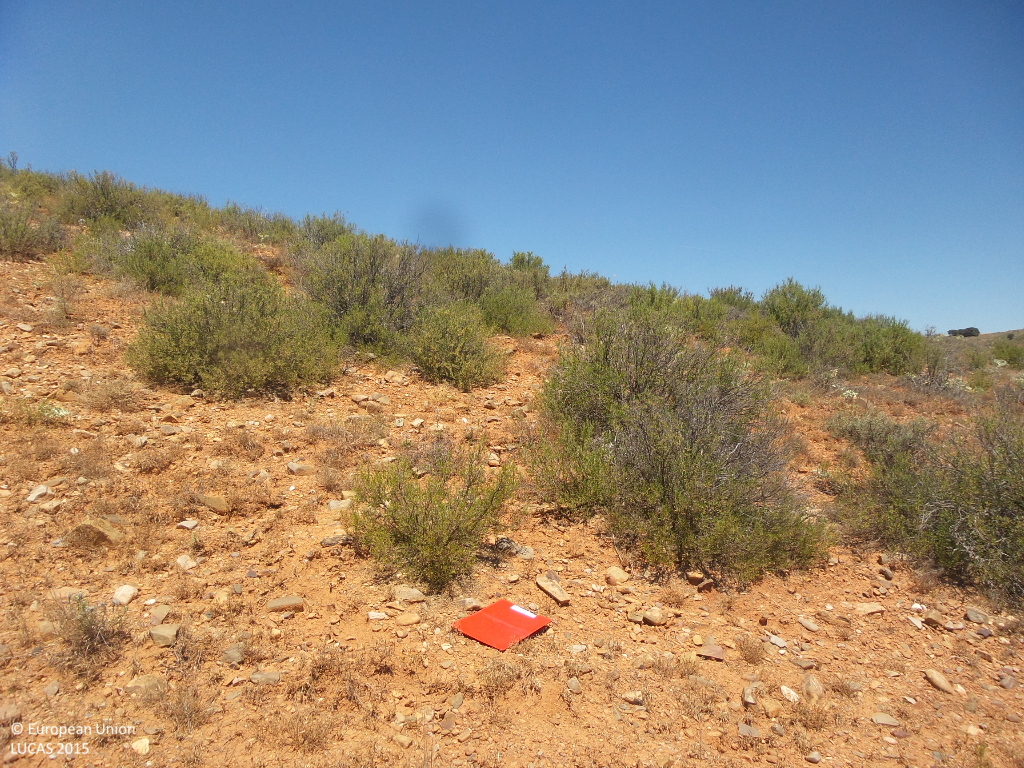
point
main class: Shrubland
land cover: Shrubland without tree cover
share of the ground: 25 - 50 %
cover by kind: unconsolidated bare surface 50 %, shrubs 40 %, herbaceous plants 10 %
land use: Semi-natural and natural areas not in use
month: July
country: ES
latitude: 41.3761
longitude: -2.1183
